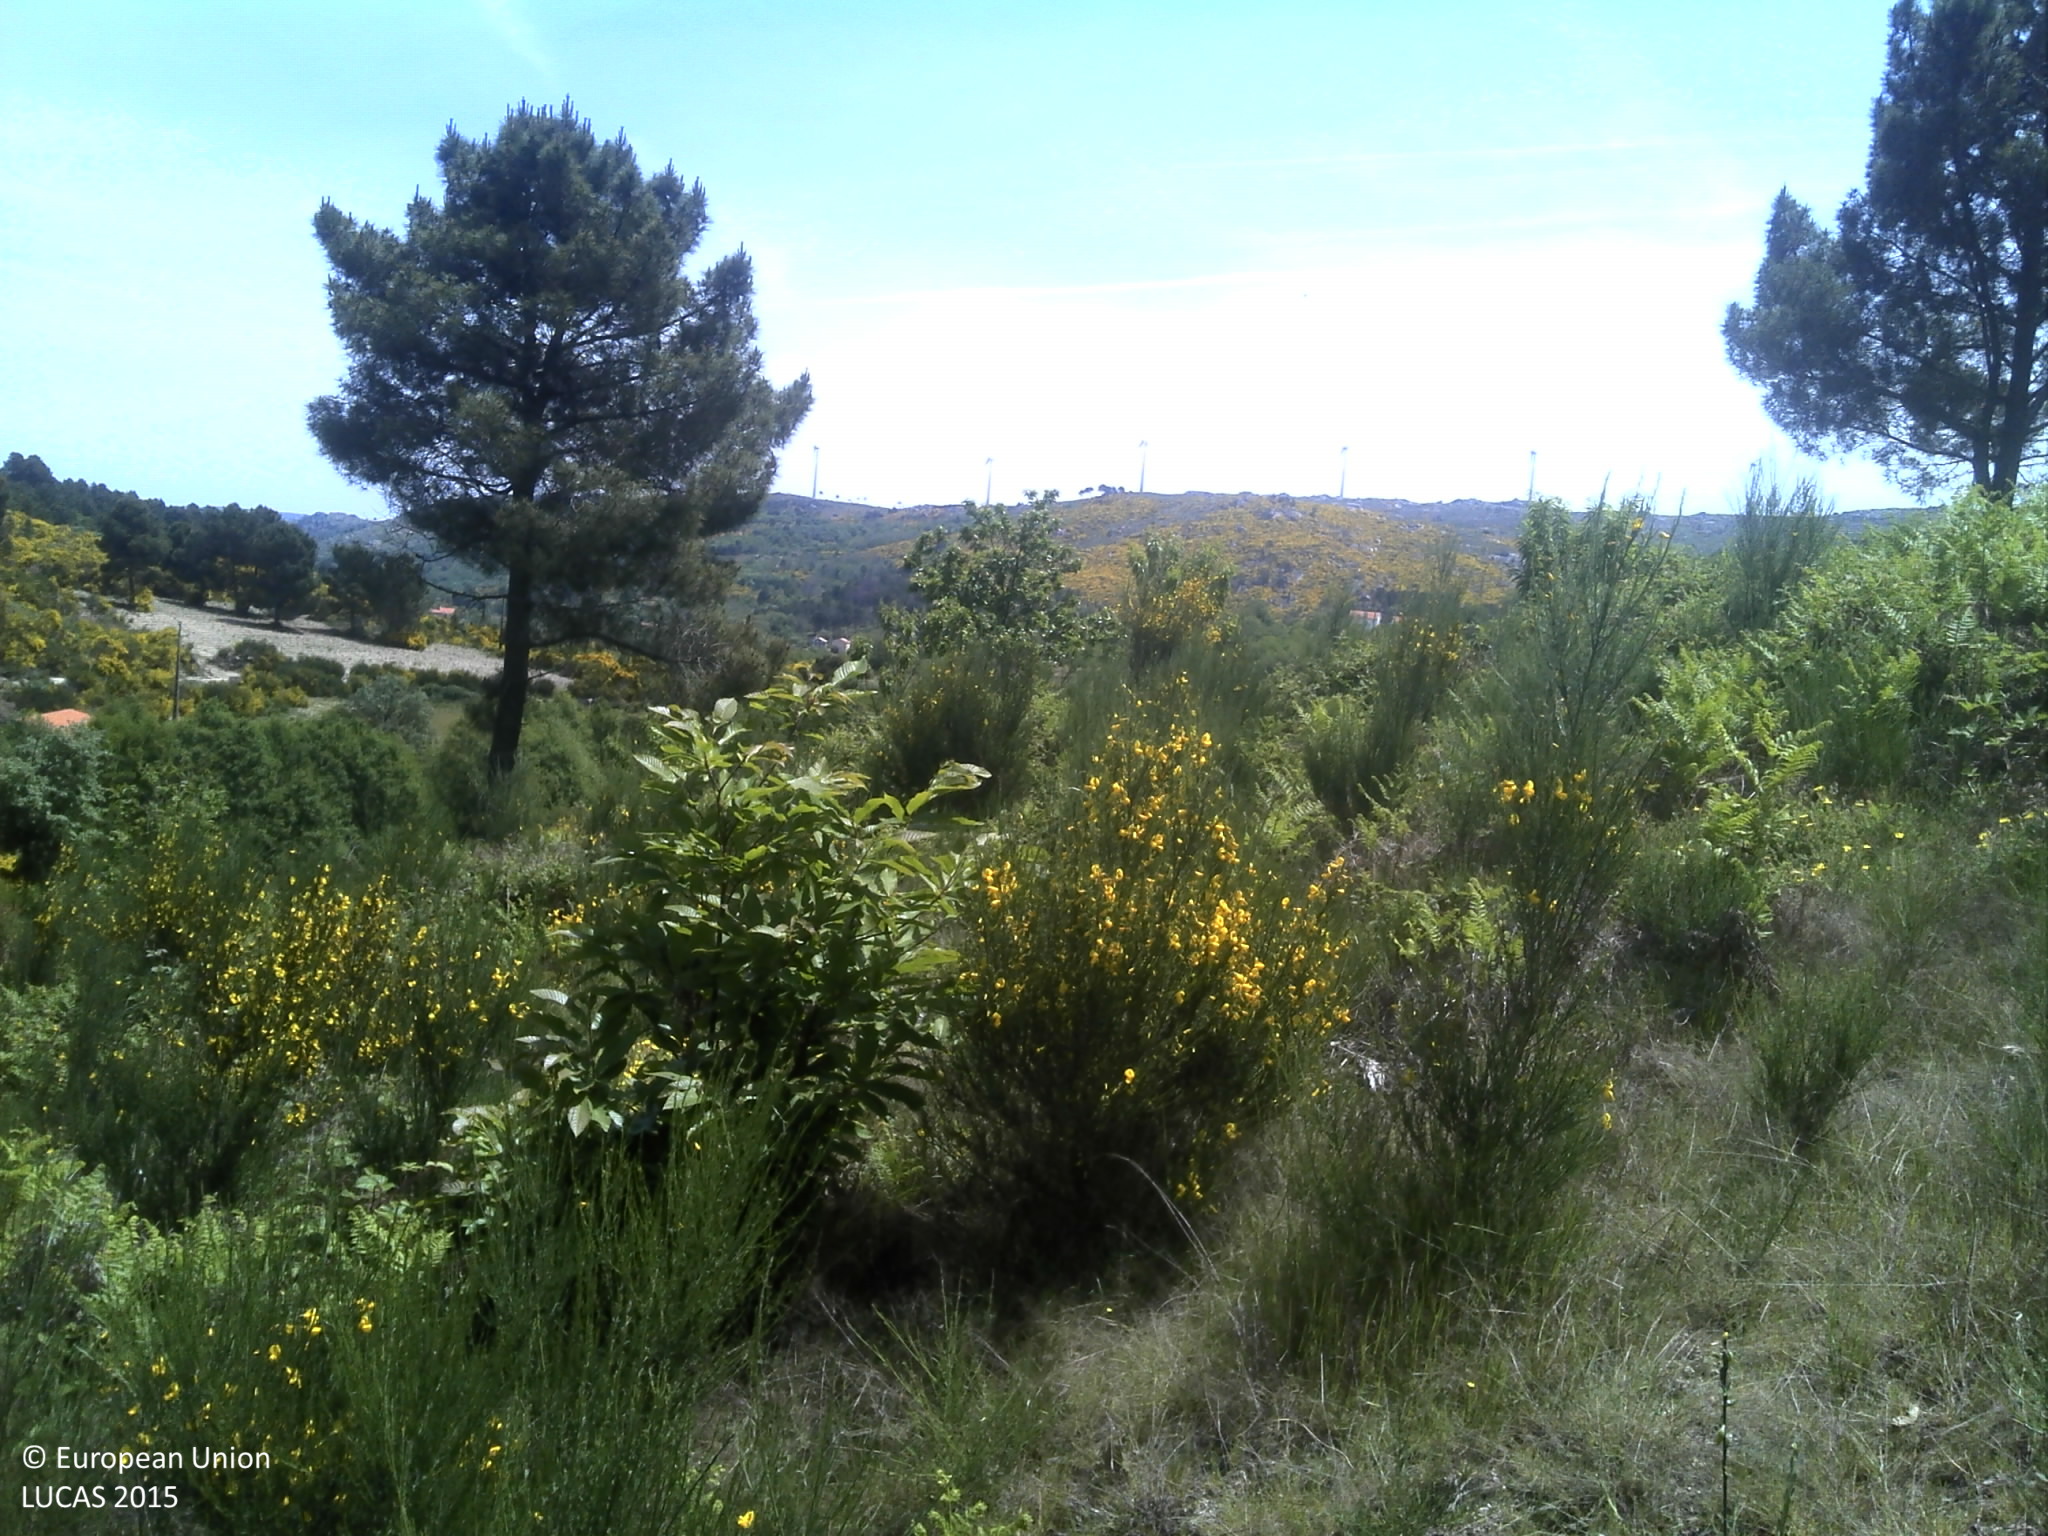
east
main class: Shrubland
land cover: Shrubland without tree cover
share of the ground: 25 - 50 %
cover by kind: shrubs 100 %
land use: Abandoned areas
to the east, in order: Shrubland without tree cover; Shrubland with sparse tree cover; Artificial constructions in urban areas; Tracks; Spontaneously vegetated surfaces; Abandoned hedges; Rivers and streams; Grassland without tree/shrub cover; Shrubland without tree cover
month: May
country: PT
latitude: 40.5646
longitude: -7.3889
